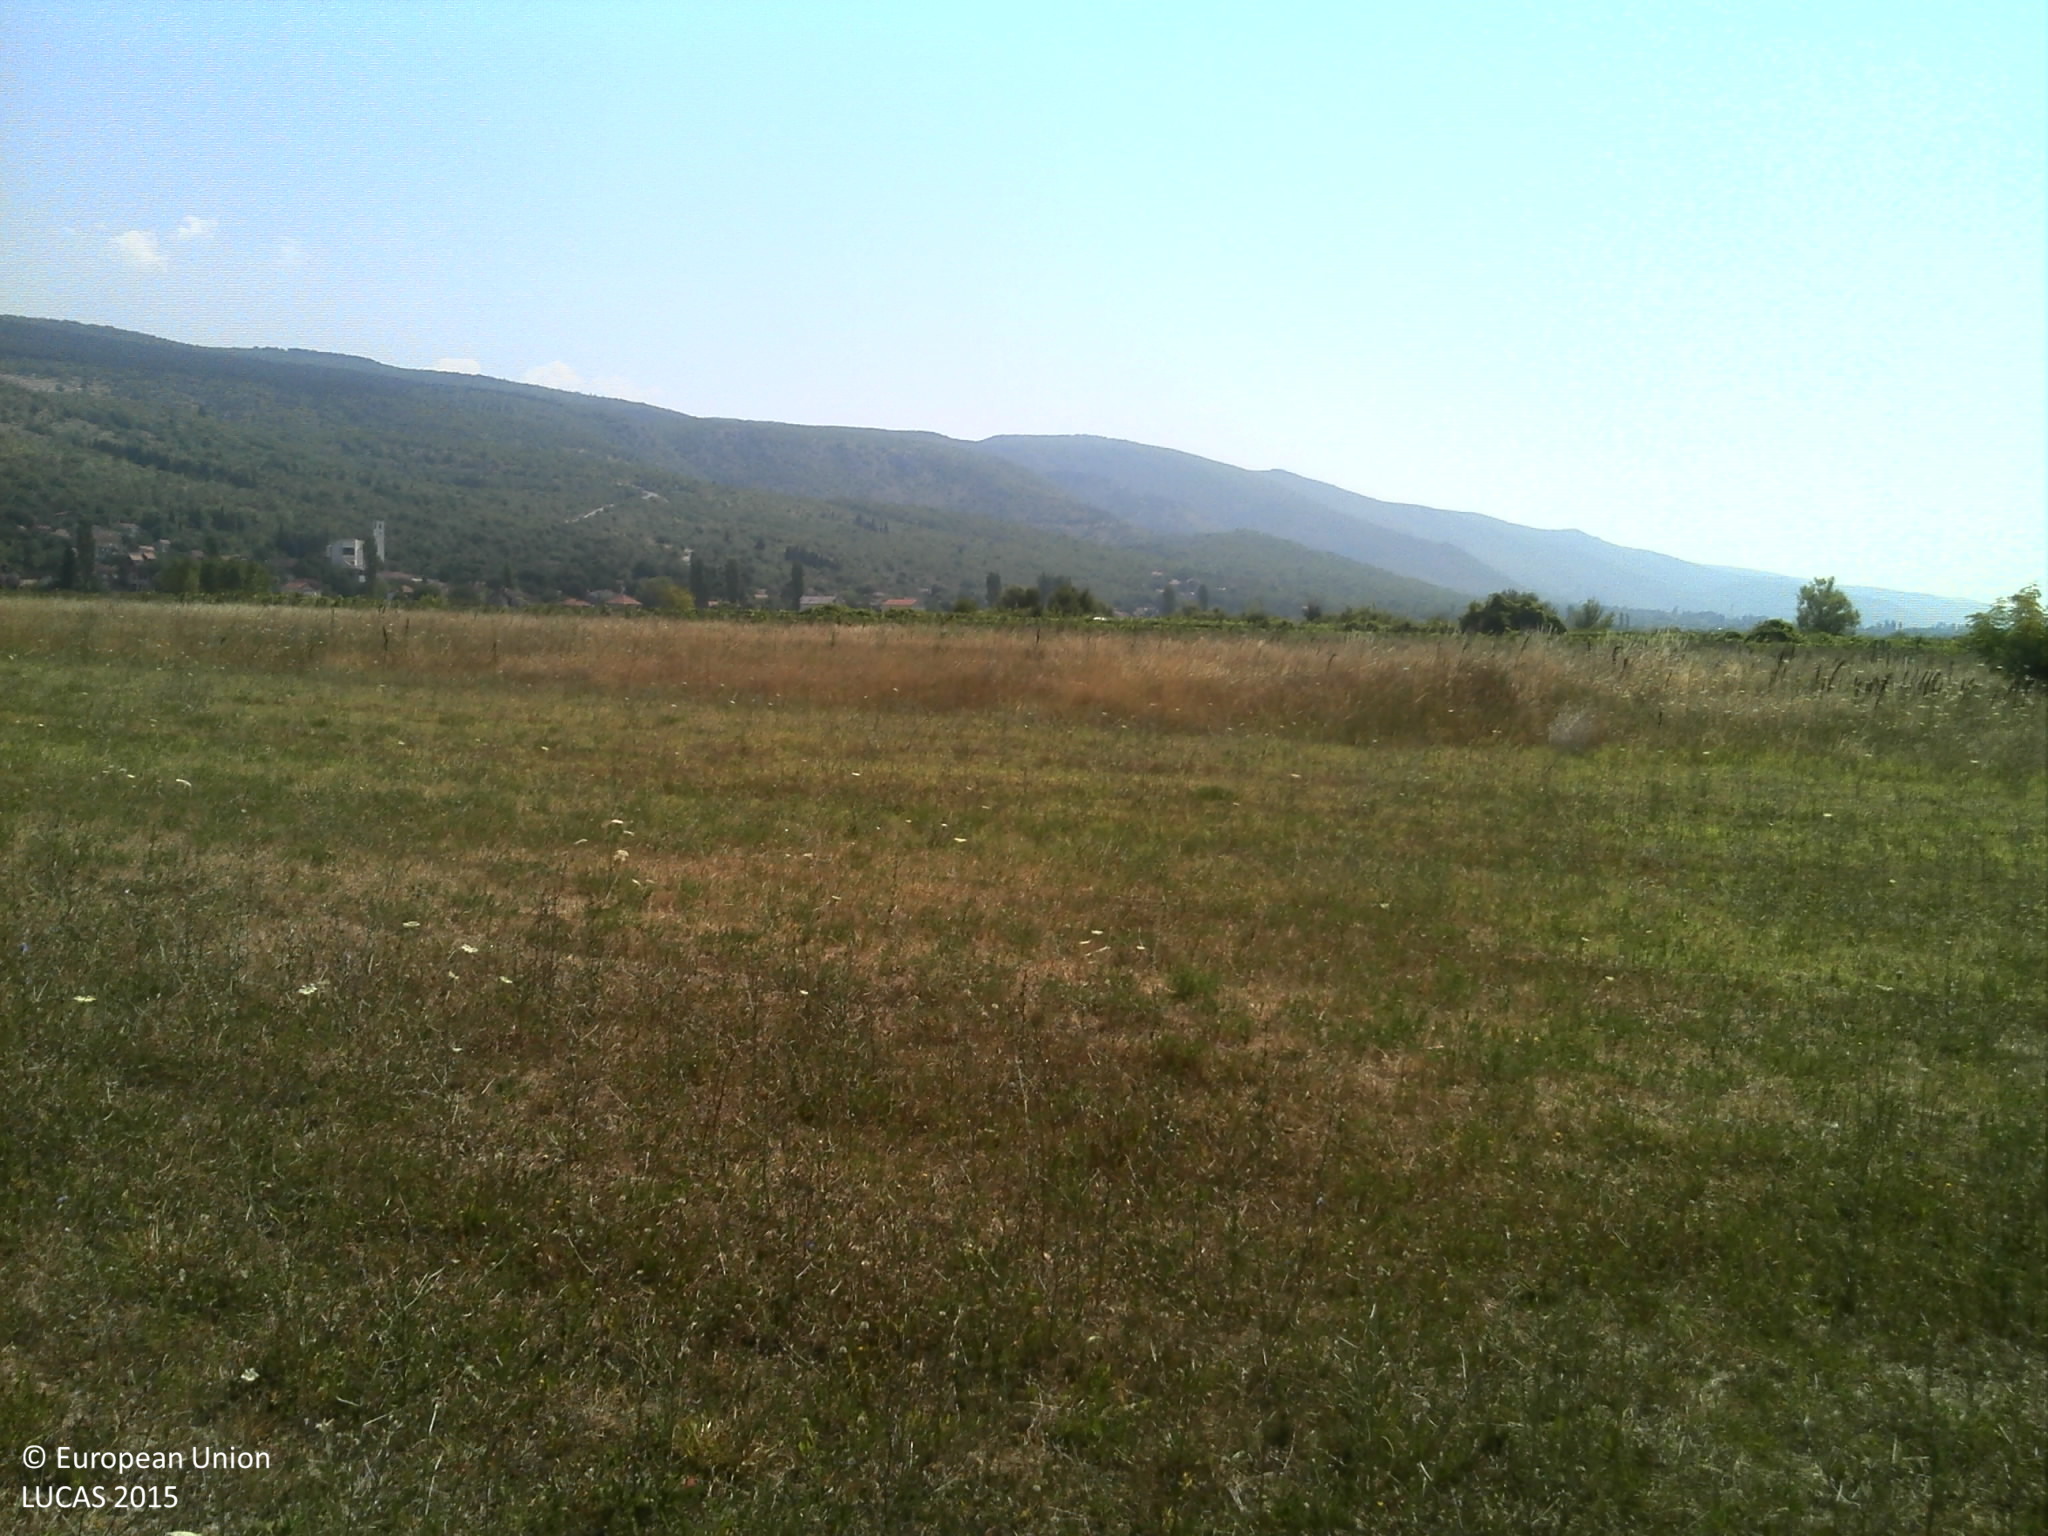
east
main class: Grassland
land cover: Grassland without tree/shrub cover
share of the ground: > 75 %
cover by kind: herbaceous plants 100 %
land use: Agriculture (excluding fallow land and kitchen gardens)
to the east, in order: Grassland without tree/shrub cover; Other fresh vegetables; Vineyards; Grassland without tree/shrub cover; Vineyards; Grassland with sparse tree/shrub cover; Grassland without tree/shrub cover; Grassland with sparse tree/shrub cover; Vineyards; Shrubland with sparse tree cover; Vineyards; Shrubland with sparse tree cover; Tracks; Vineyards
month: July
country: HR
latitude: 43.4273
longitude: 17.2429
